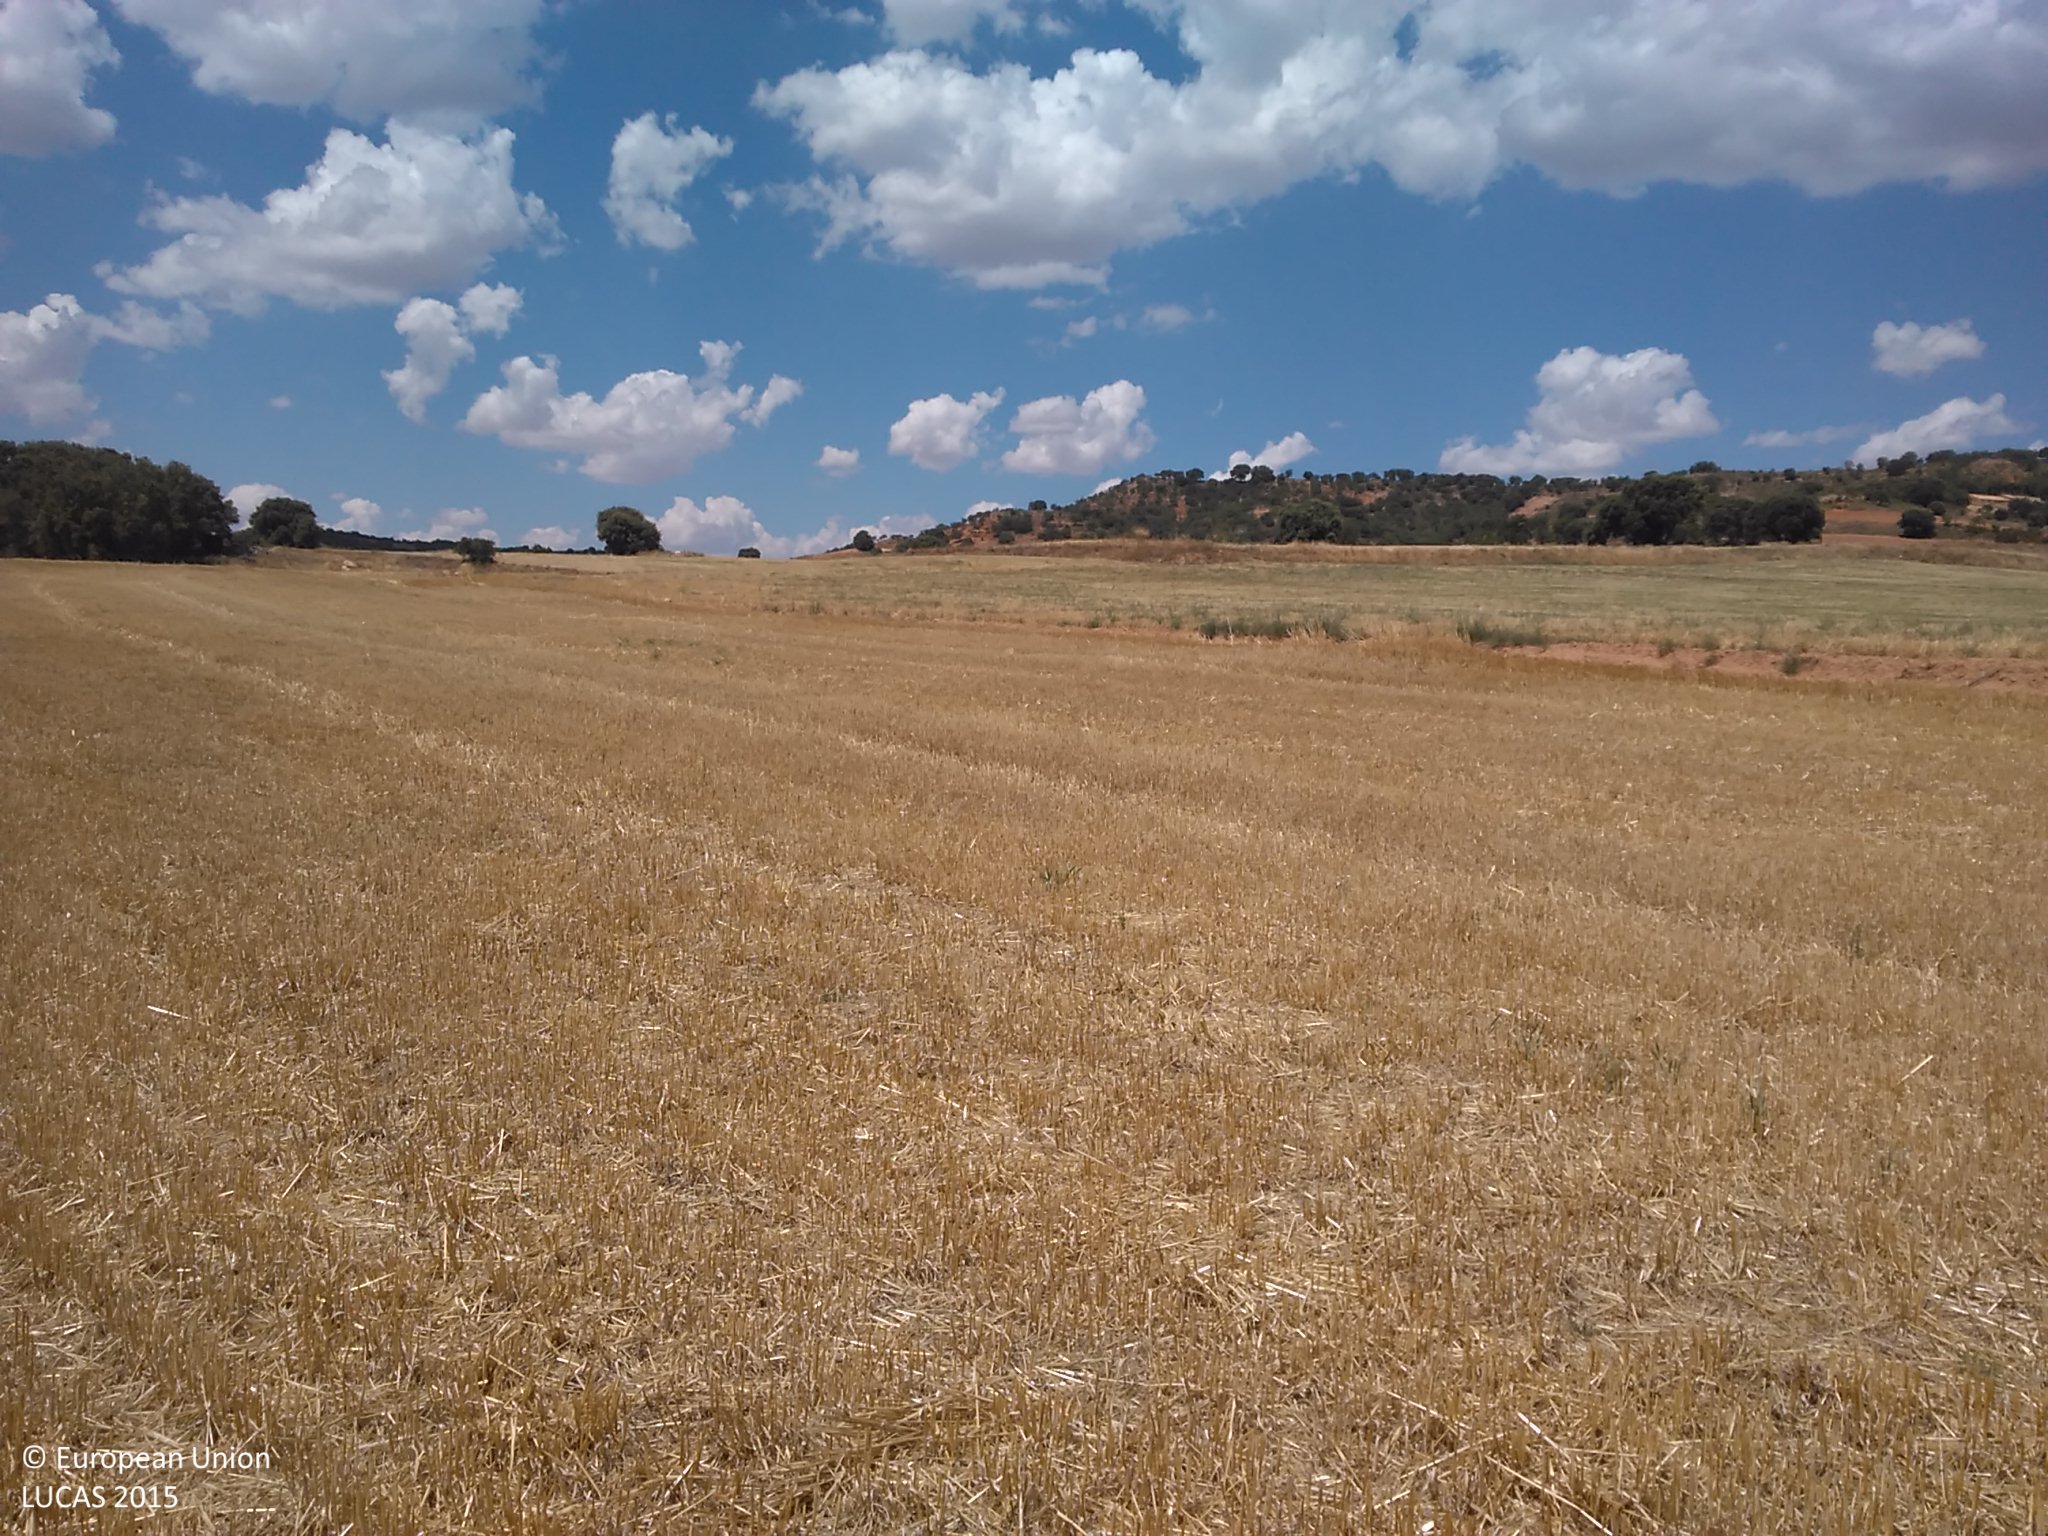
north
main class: Cropland
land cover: Barley
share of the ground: < 10 %
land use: Agriculture (excluding fallow land and kitchen gardens)
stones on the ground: < 10 %
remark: Harvested field
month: July
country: ES
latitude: 41.4532
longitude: -2.0852
